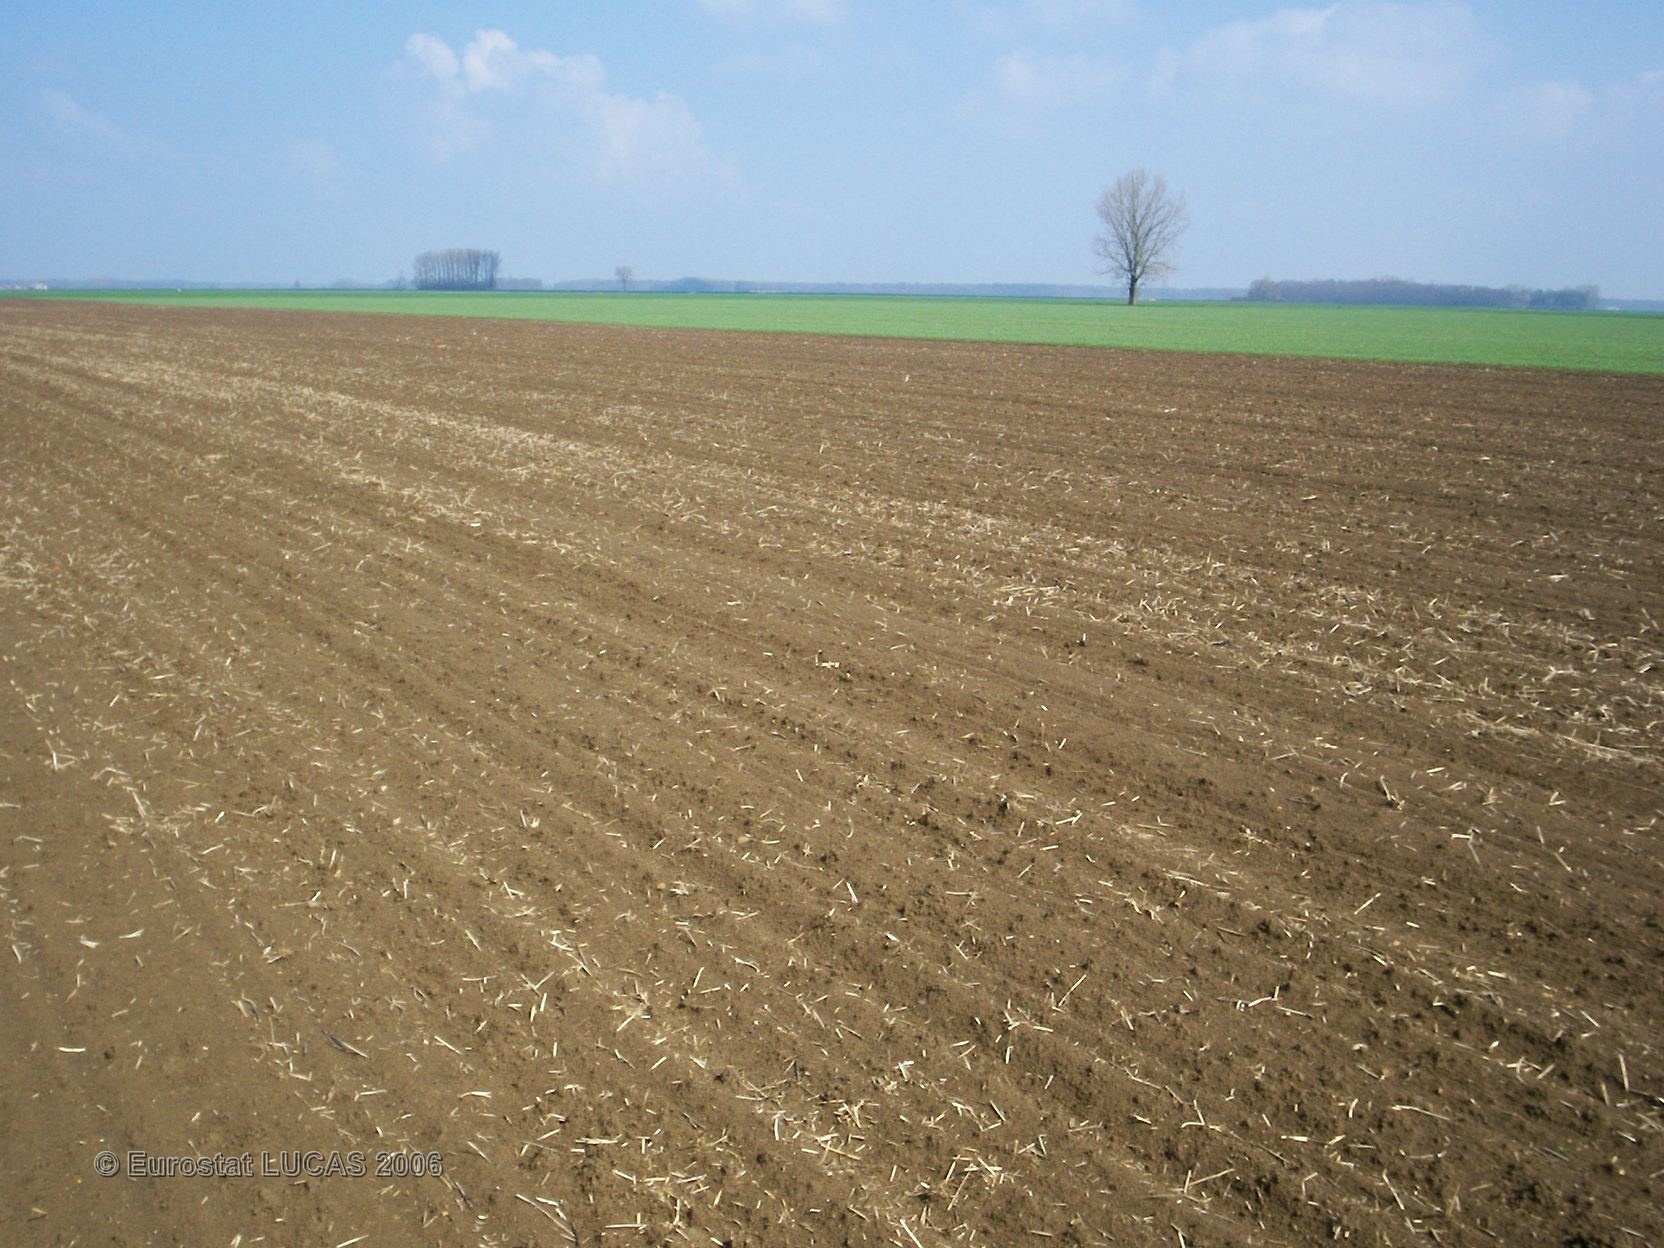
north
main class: Cropland
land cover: Sugar beet
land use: Agriculture (excluding fallow land and kitchen gardens)
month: June
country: FR
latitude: 47.0080
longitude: 5.3585
